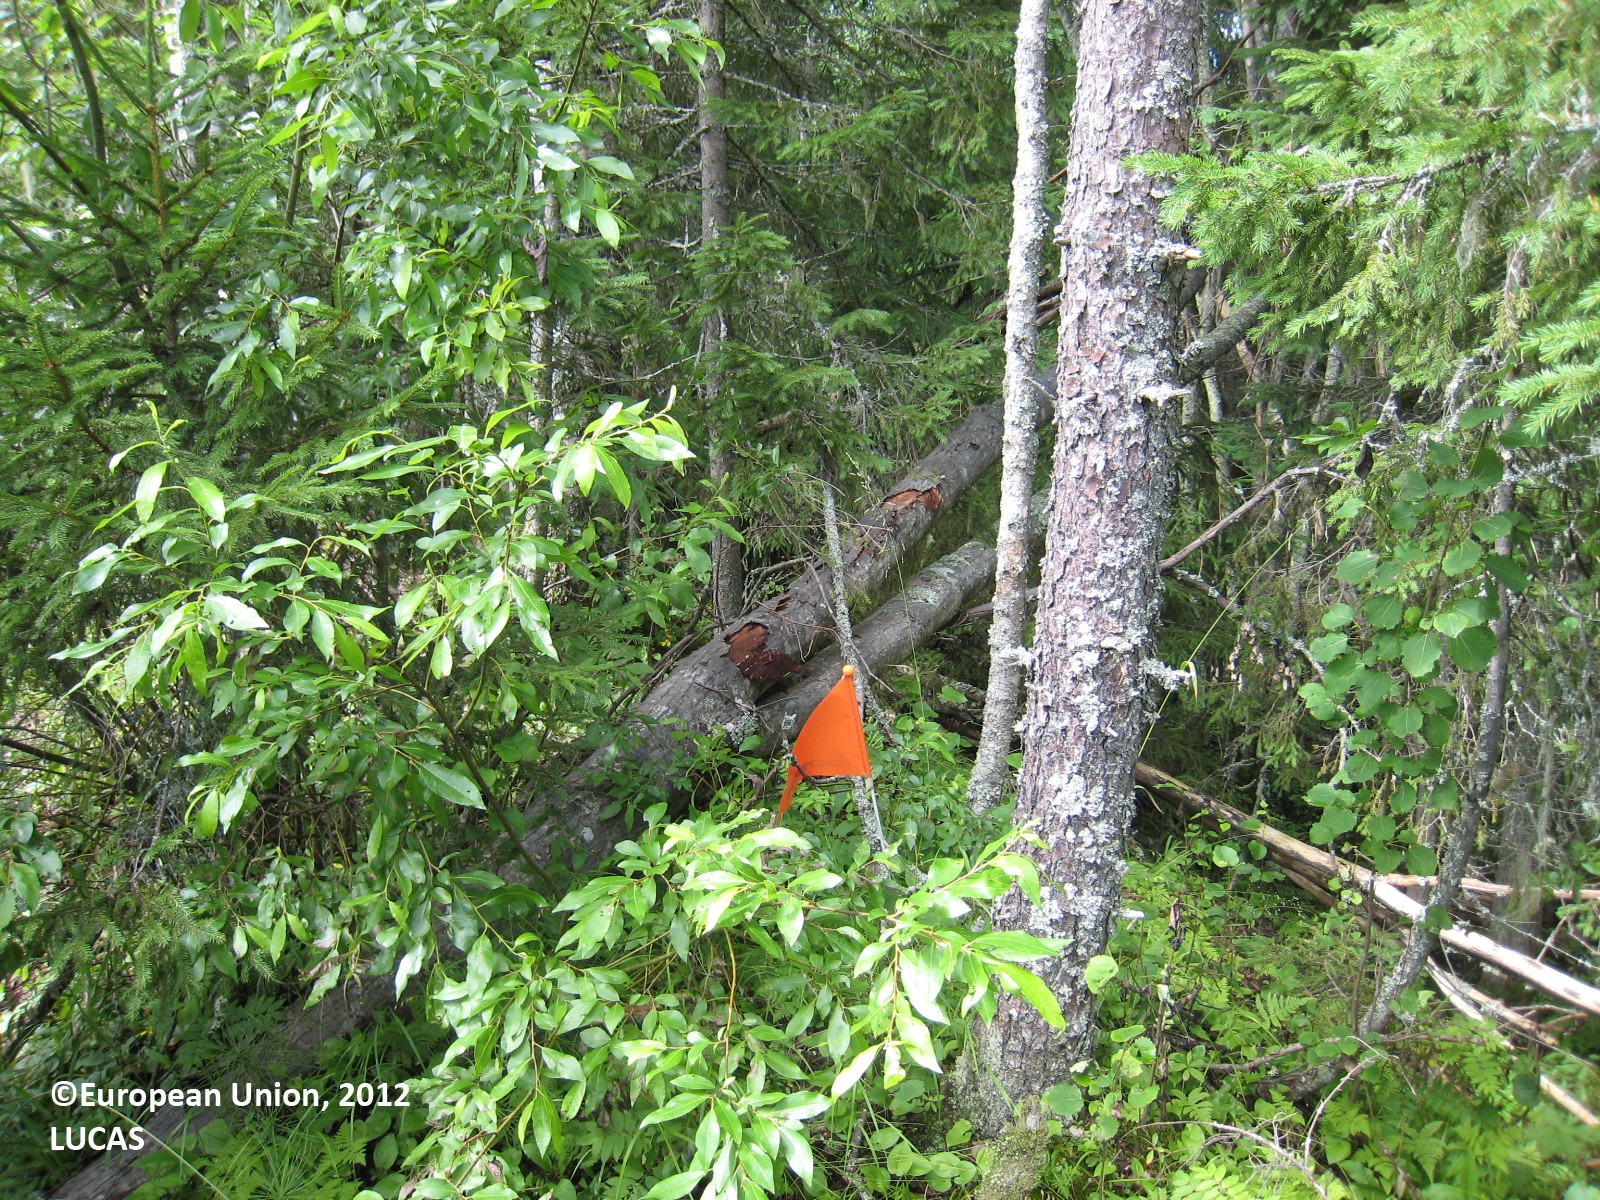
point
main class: Woodland
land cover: Other mixed woodland
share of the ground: > 75 %
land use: Semi-natural and natural areas not in use
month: July
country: FI
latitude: 63.2678
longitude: 26.8165
